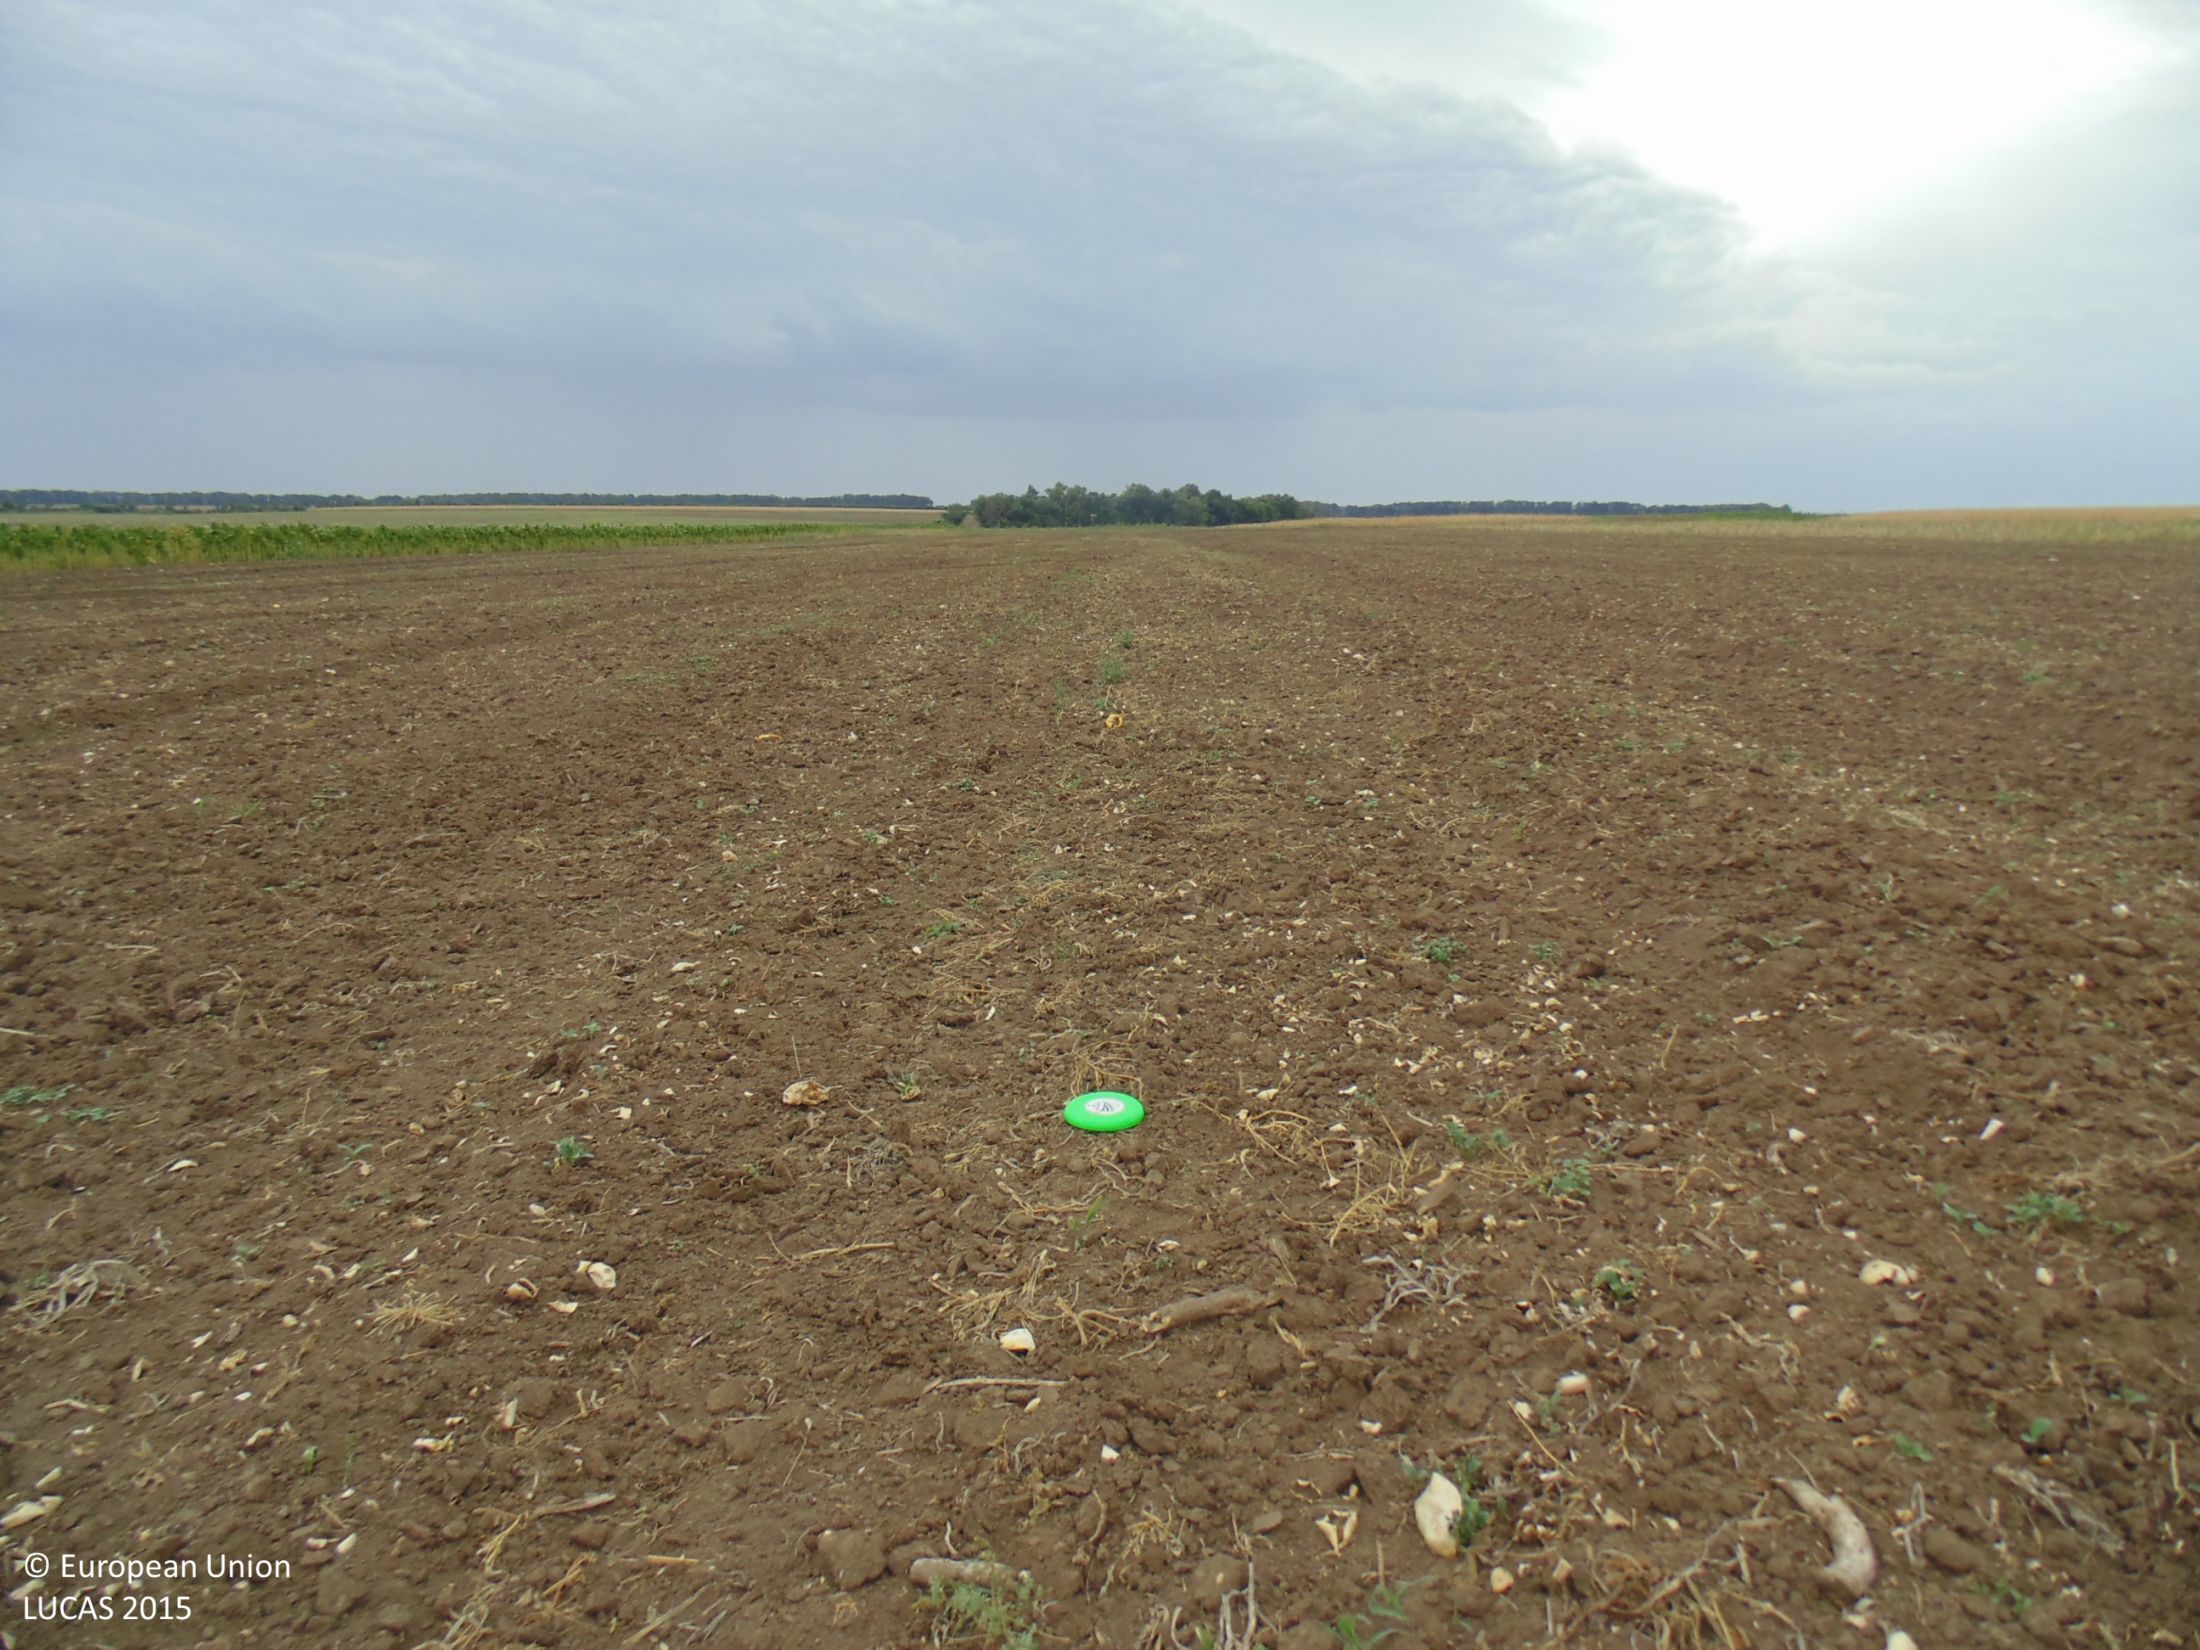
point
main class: Cropland
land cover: Other fresh vegetables
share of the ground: < 10 %
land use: Agriculture (excluding fallow land and kitchen gardens)
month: September
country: BG
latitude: 44.0030
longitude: 26.9972
